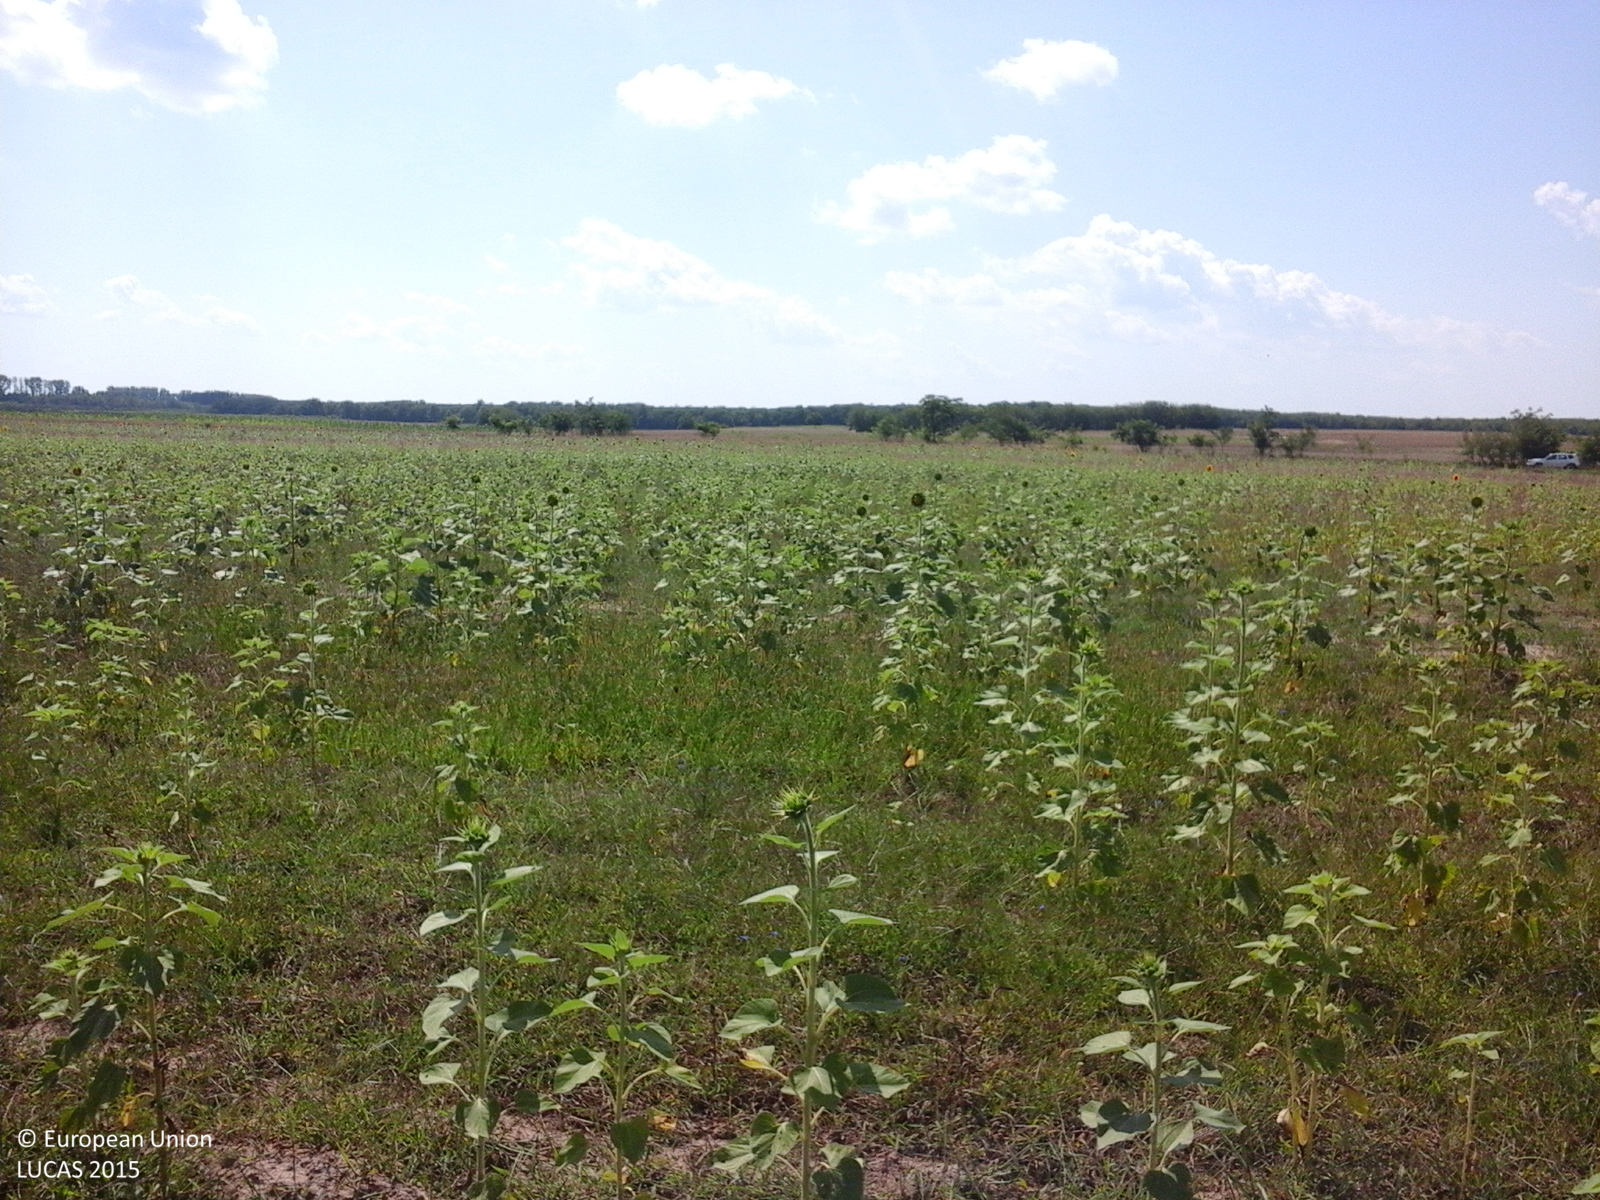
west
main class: Cropland
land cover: Sunflower
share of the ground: > 75 %
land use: Agriculture (excluding fallow land and kitchen gardens)
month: July
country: RO
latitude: 44.0196
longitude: 24.1190
